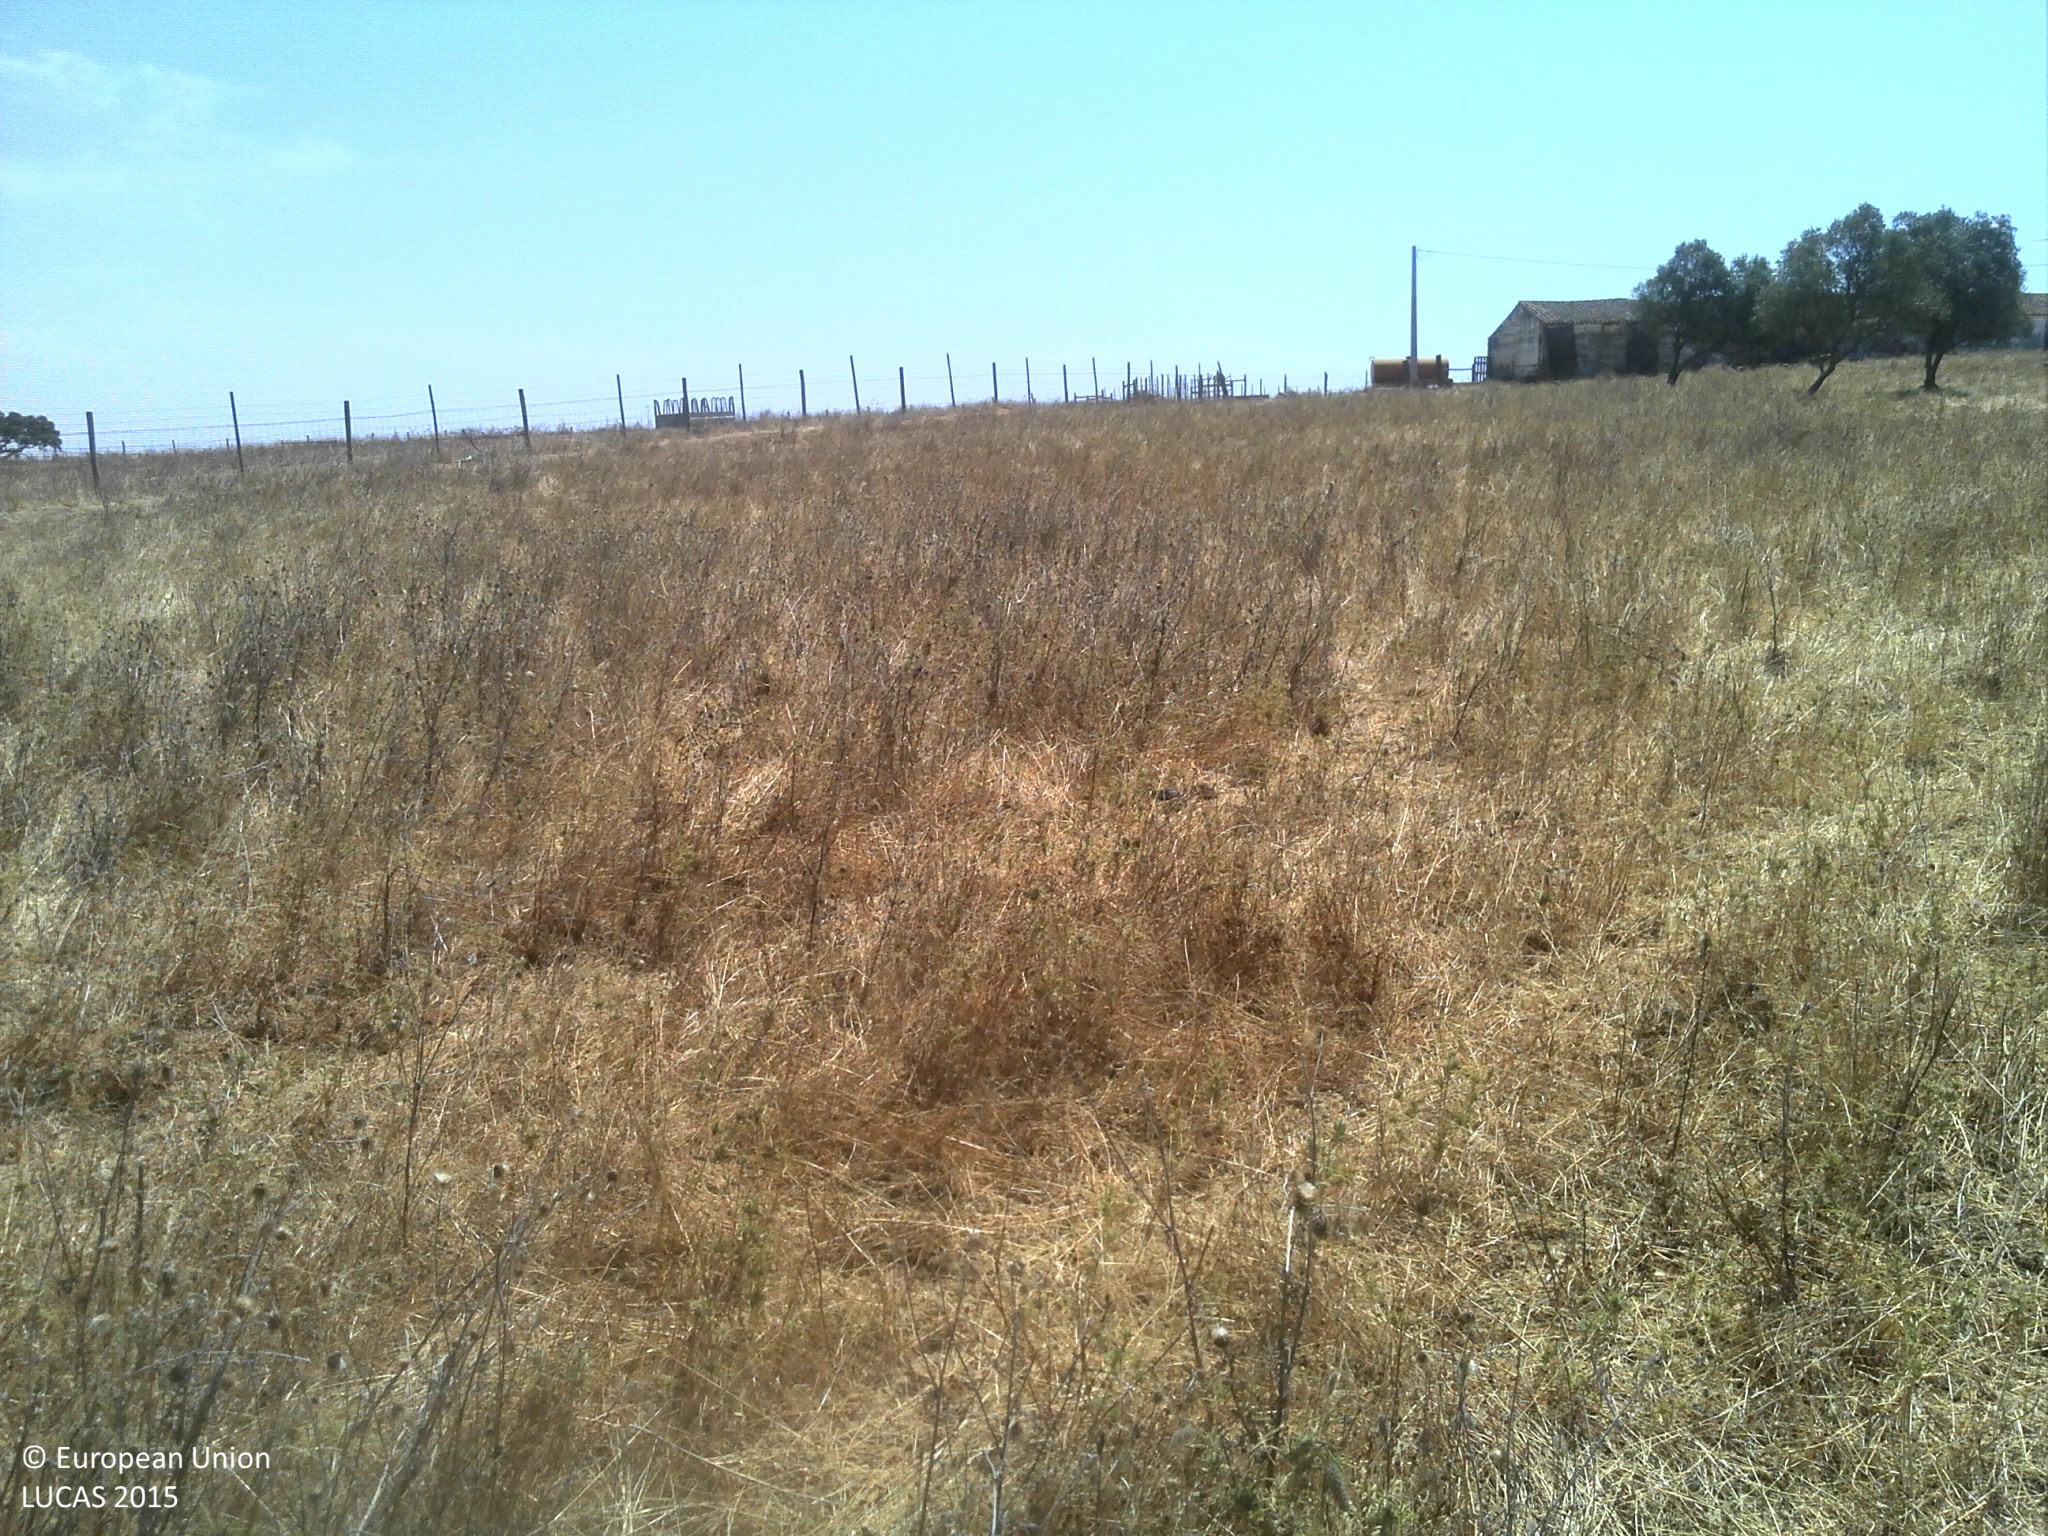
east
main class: Grassland
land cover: Grassland without tree/shrub cover
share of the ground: 25 - 50 %
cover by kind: herbaceous plants 60 %, consolidated bare surface 40 %
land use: Agriculture (excluding fallow land and kitchen gardens)
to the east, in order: Grassland without tree/shrub cover; Fences; Artificial constructions in urban areas; Fences; Grassland without tree/shrub cover; Fences; Broadleaved woodland
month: July
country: PT
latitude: 37.6829
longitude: -8.2756
